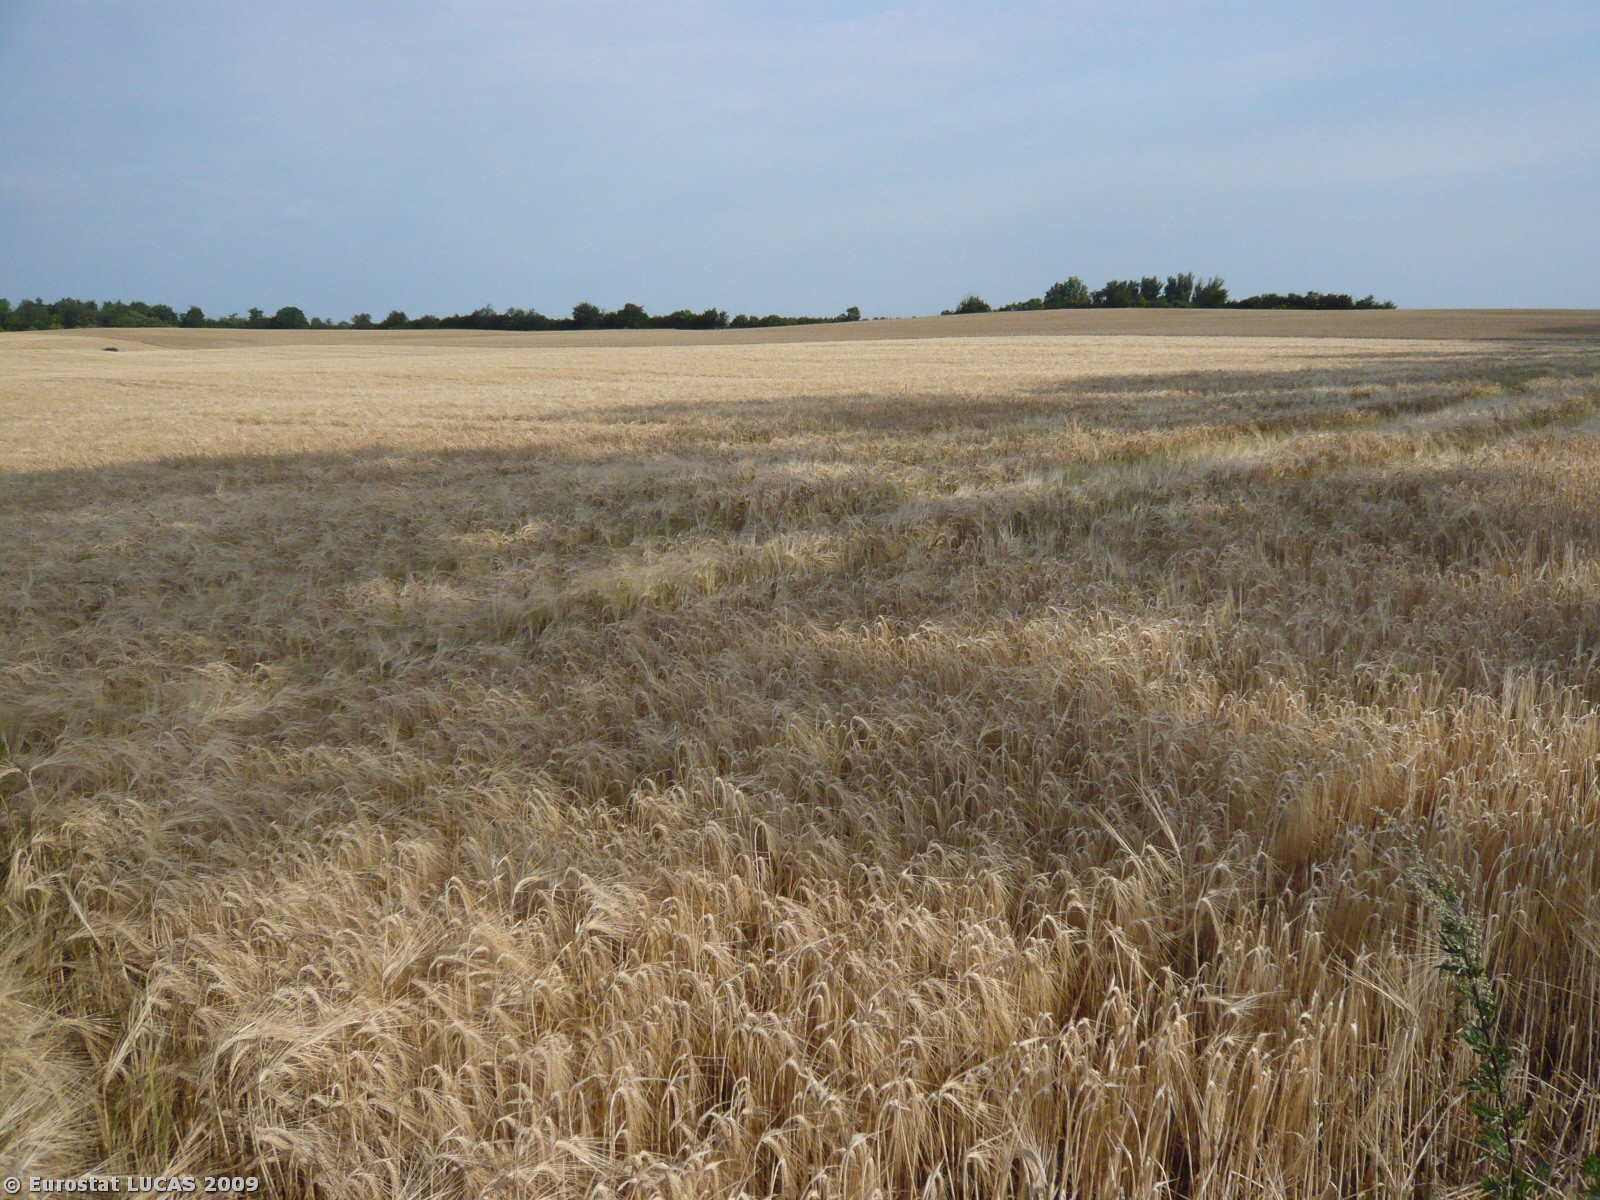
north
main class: Cropland
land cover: Barley
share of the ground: > 75 %
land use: Agriculture (excluding fallow land and kitchen gardens)
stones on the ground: < 10 %
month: August
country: DK
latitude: 55.9897
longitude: 12.1620
